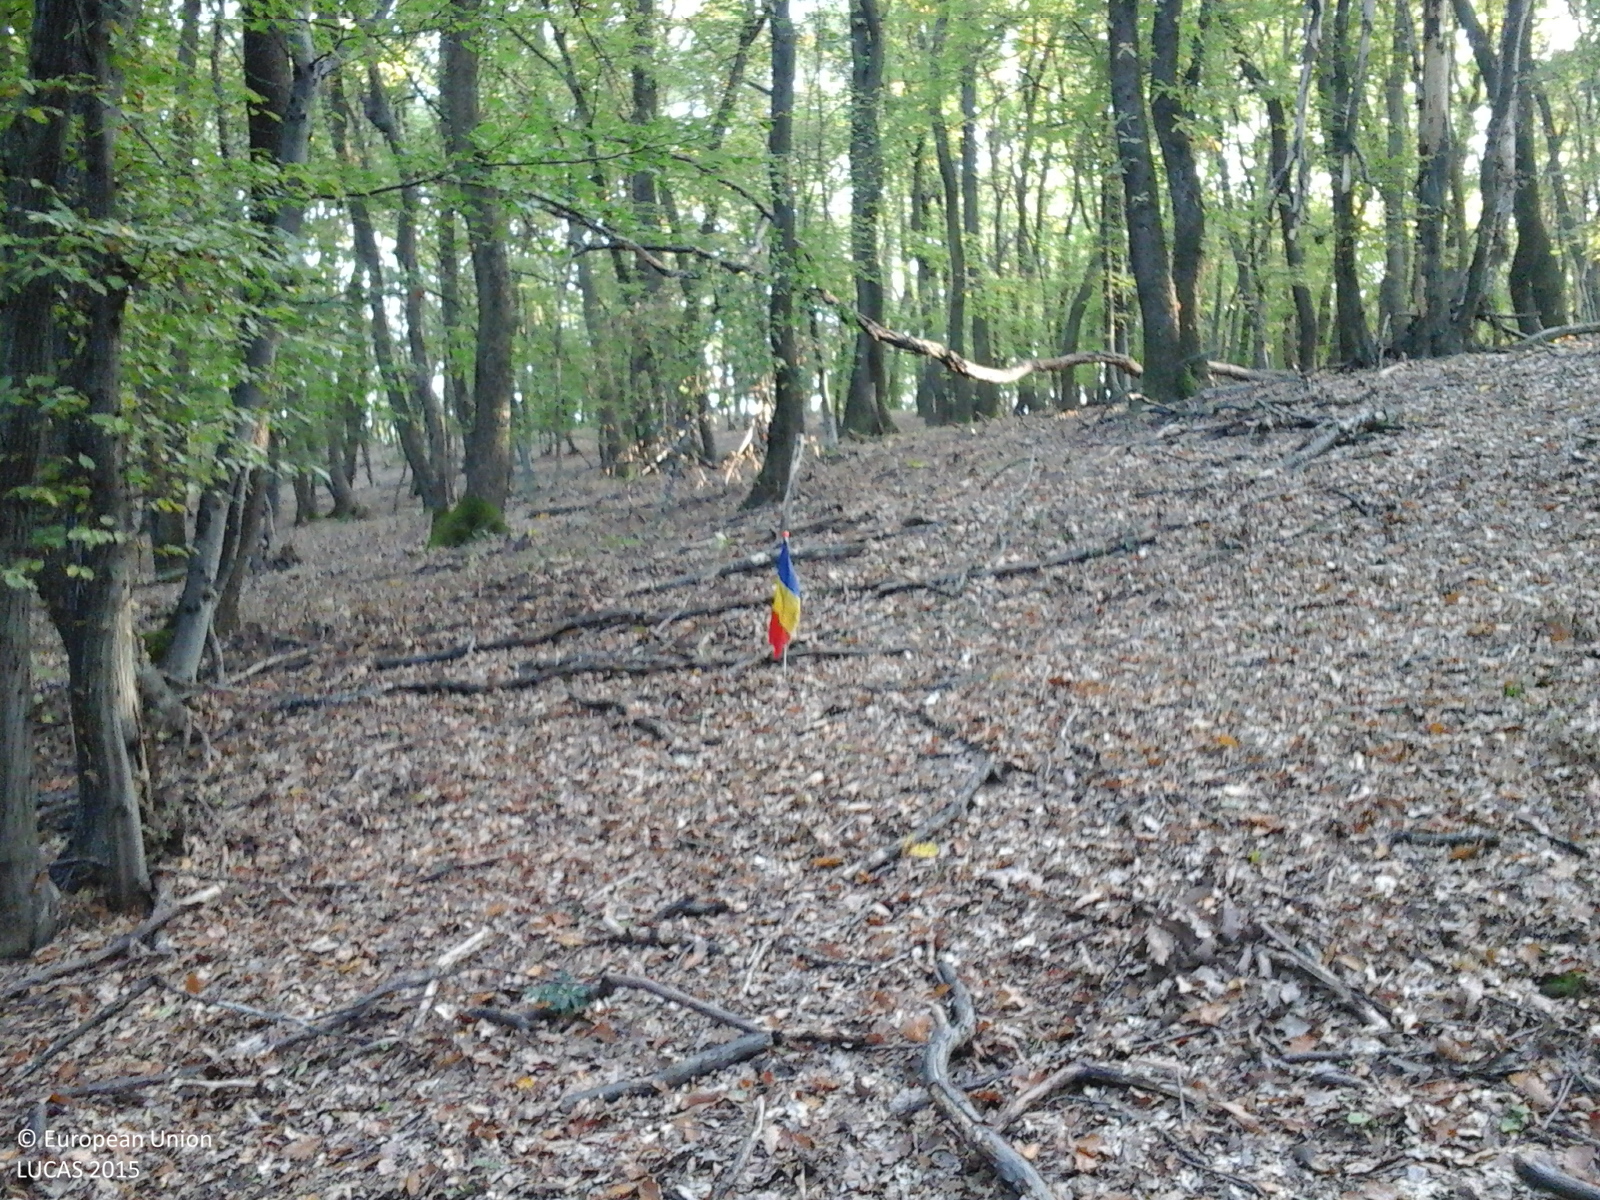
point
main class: Woodland
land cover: Broadleaved woodland
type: acidophilous oak and oak-birch forest
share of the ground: > 75 %
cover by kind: broadleaved forest trees 100 %
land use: Forestry
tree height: > 5 m
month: October
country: RO
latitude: 46.1821
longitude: 24.2127
